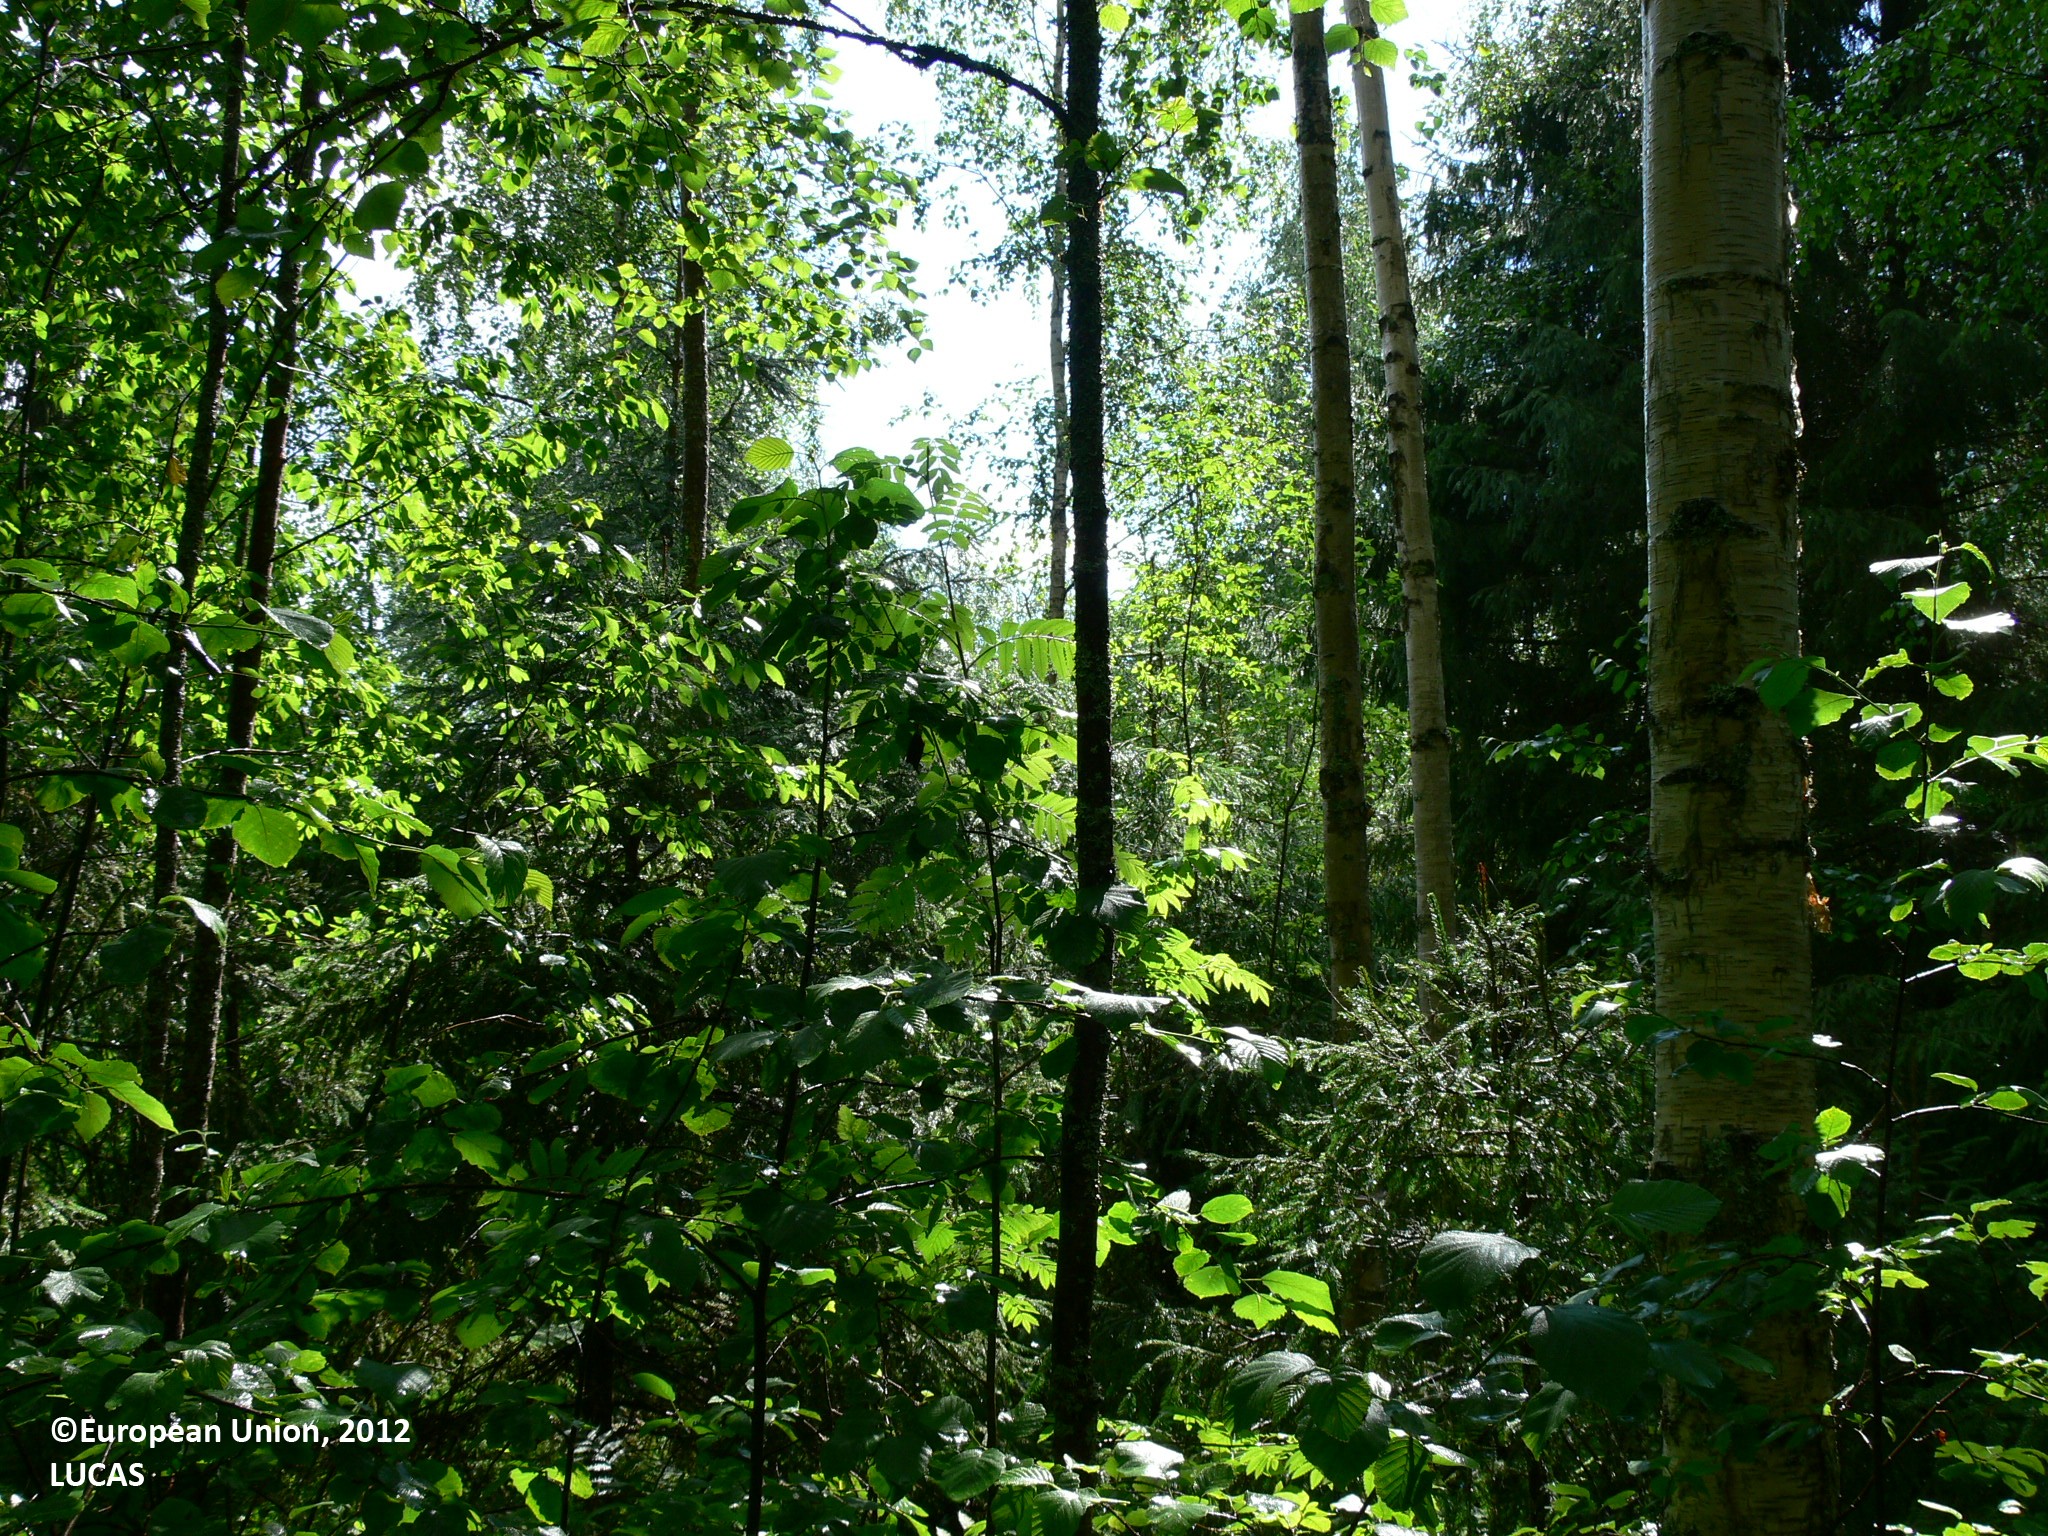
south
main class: Woodland
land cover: Spruce dominated mixed woodland
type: boreal forest
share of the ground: > 75 %
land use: Forestry
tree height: > 5 m
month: July
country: FI
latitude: 63.2412
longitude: 29.9376
